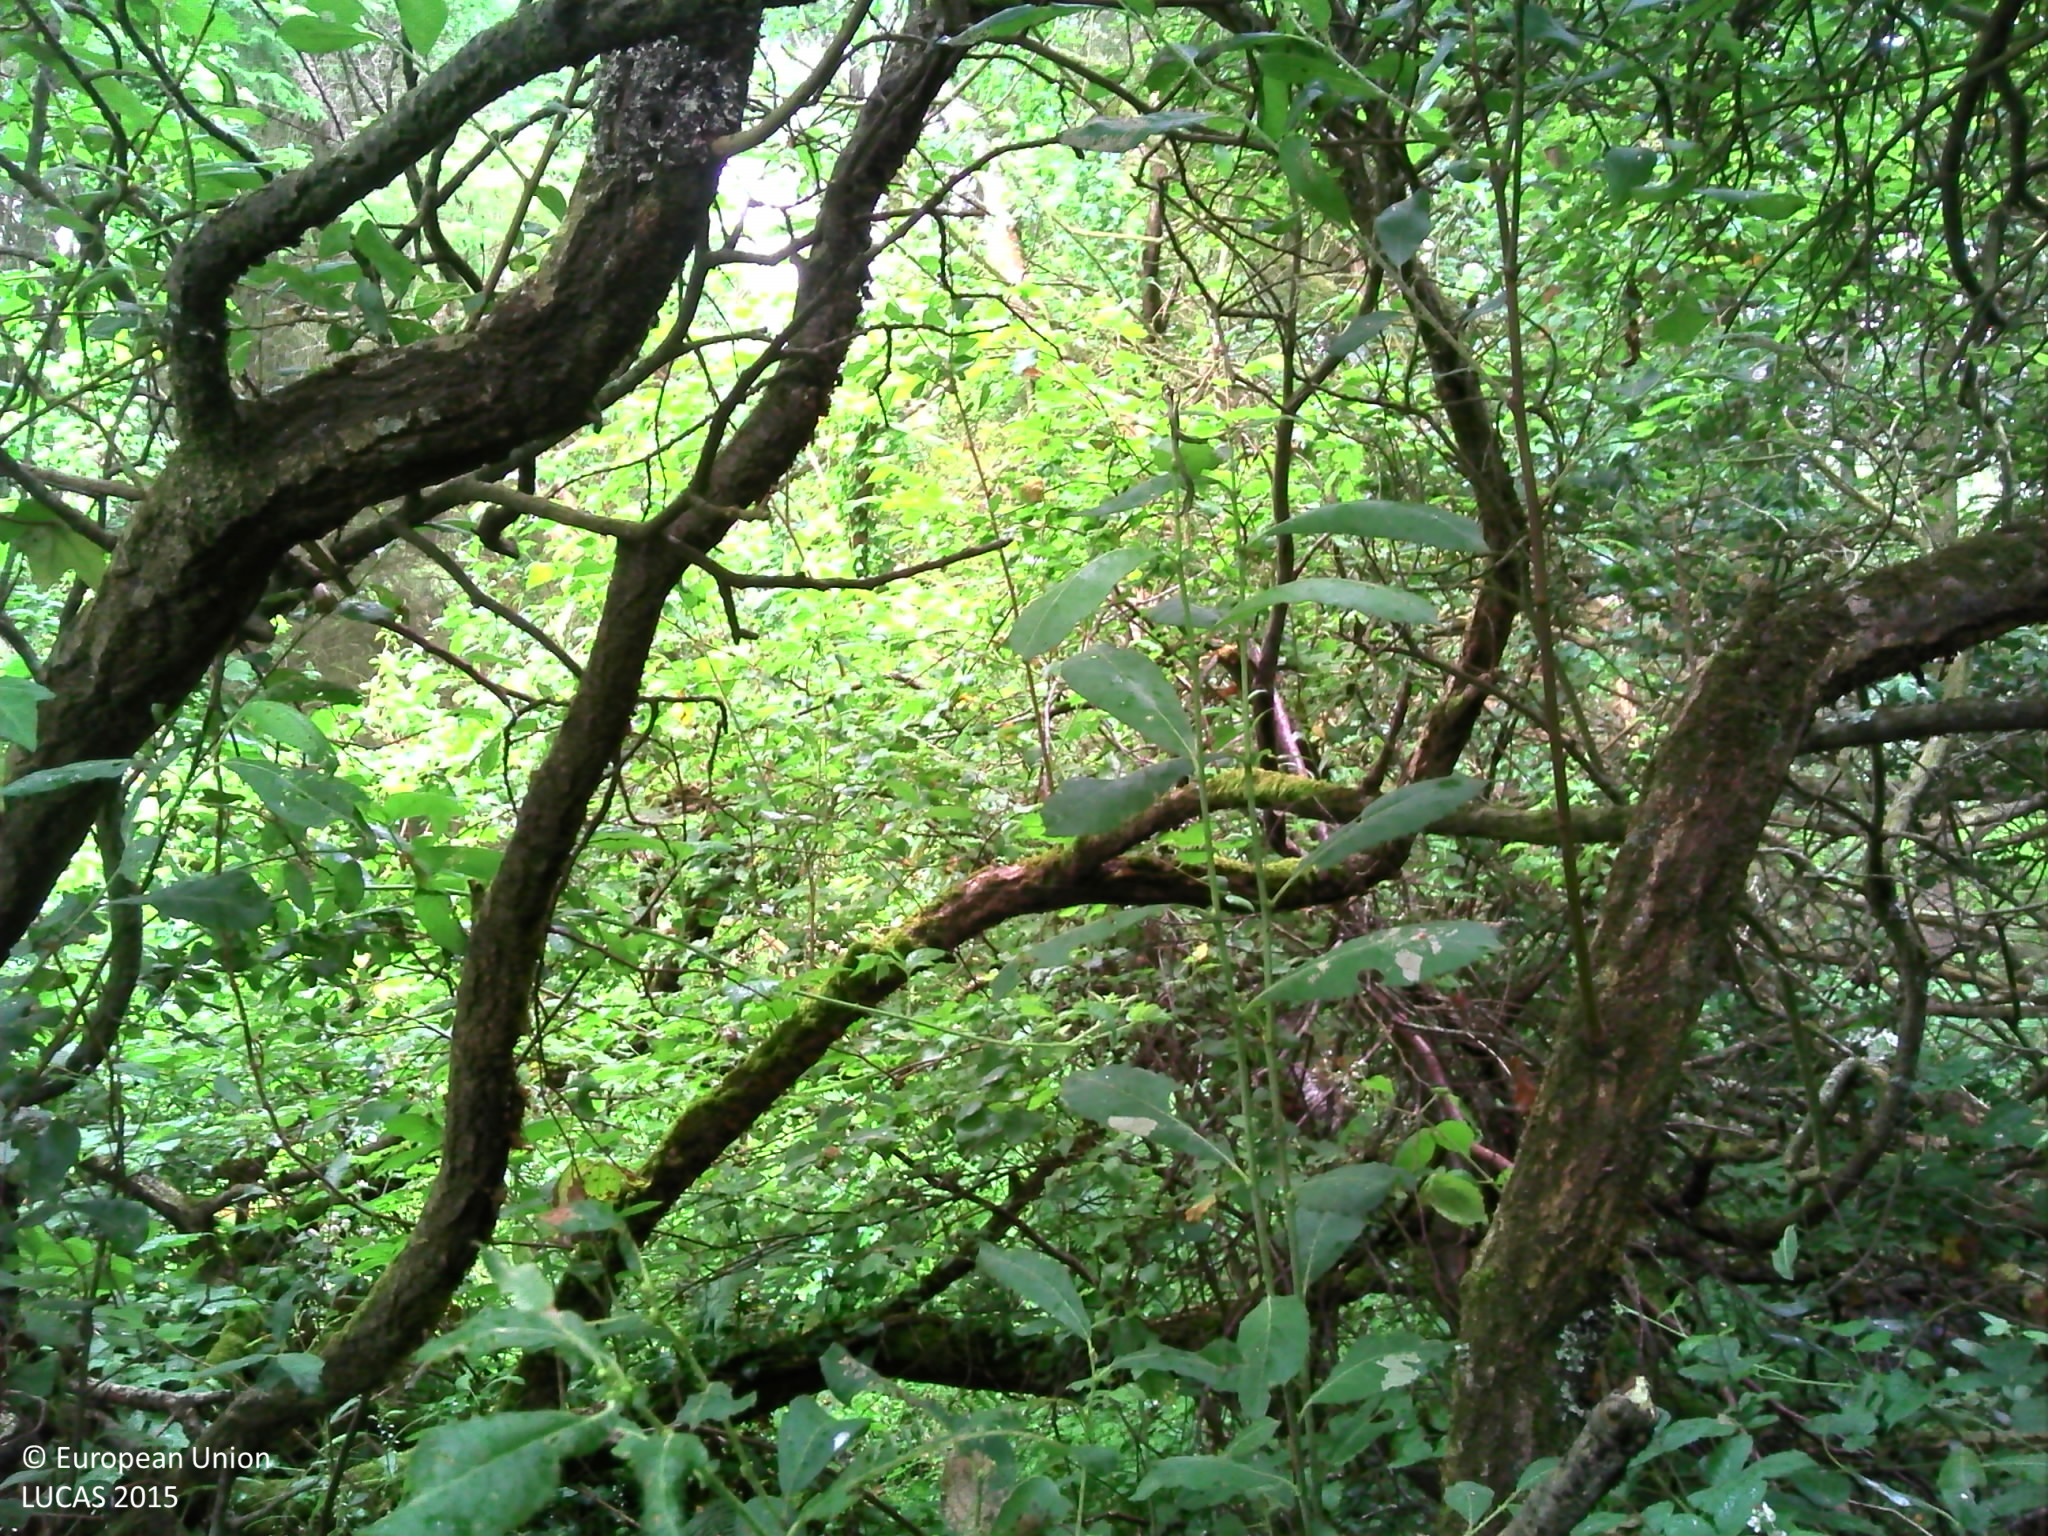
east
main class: Woodland
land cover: Broadleaved woodland
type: mesophytic deciduous forest
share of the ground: > 75 %
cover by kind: herbaceous plants 50 %, broadleaved forest trees 30 %, coniferous forest trees 10 %, unconsolidated bare surface 10 %
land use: Forestry
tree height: > 5 m
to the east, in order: Broadleaved woodland; Grassland without tree/shrub cover; Broadleaved woodland; Grassland with sparse tree/shrub cover; Broadleaved woodland; Inland fresh water bodies; Artificial constructions in urban areas
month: July
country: FR
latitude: 48.5793
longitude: -3.4571
